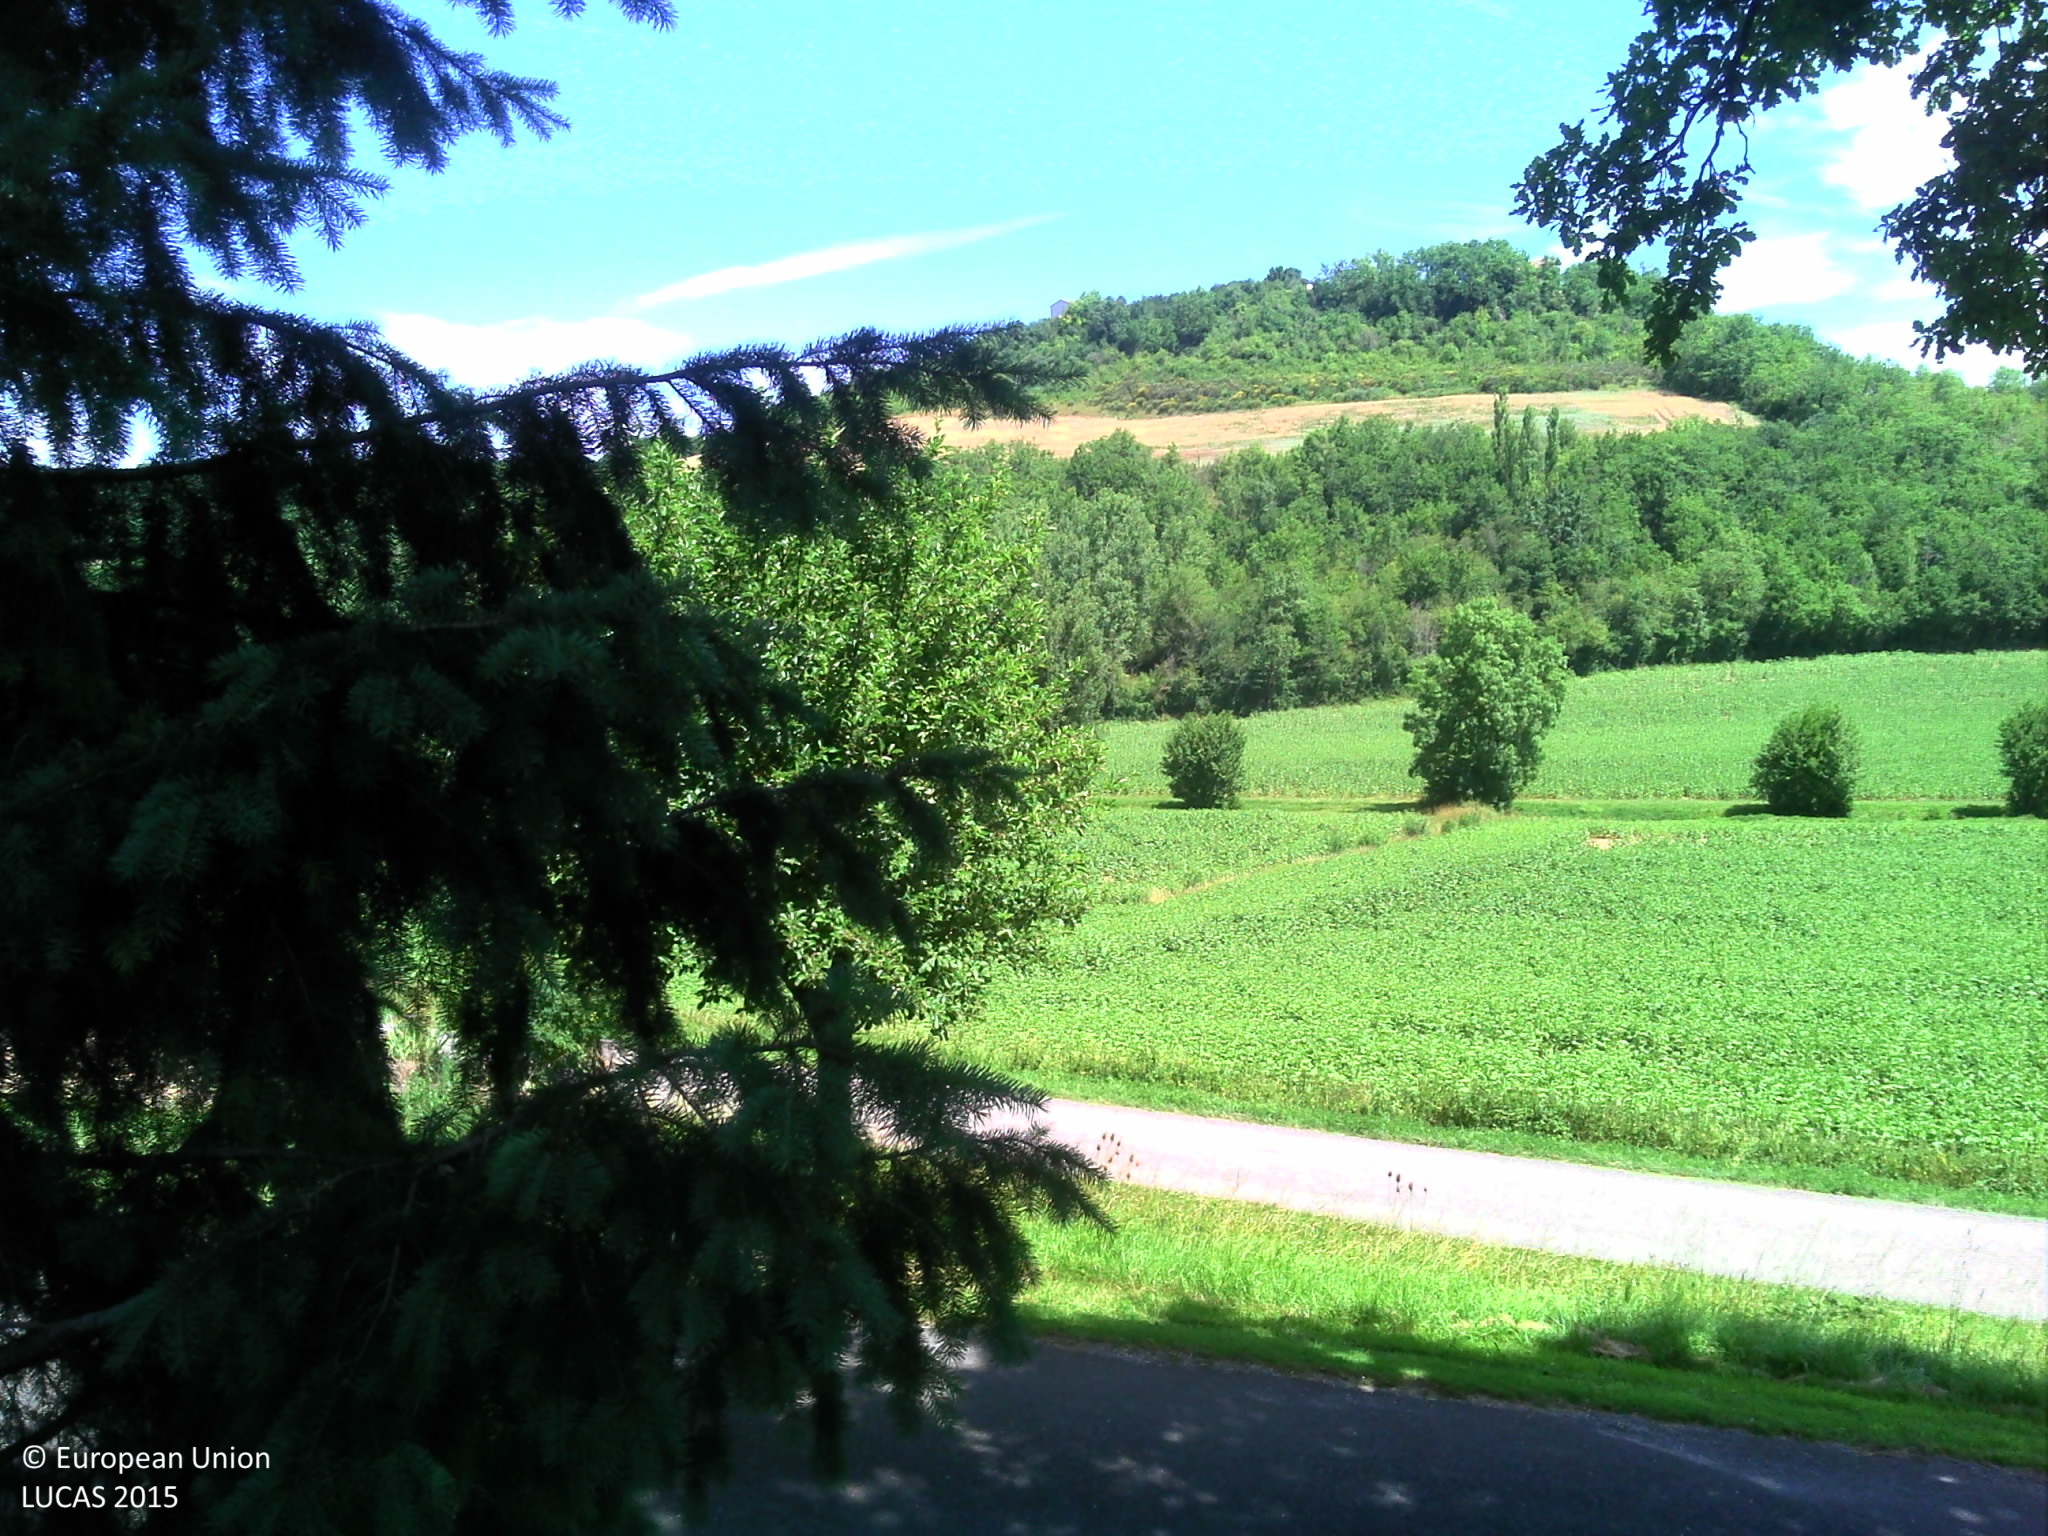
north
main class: Grassland
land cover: Grassland with sparse tree/shrub cover
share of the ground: > 75 %
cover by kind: herbaceous plants 95 %, coniferous forest trees 5 %
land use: Semi-natural and natural areas not in use
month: June
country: FR
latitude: 44.0474
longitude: 2.0777
